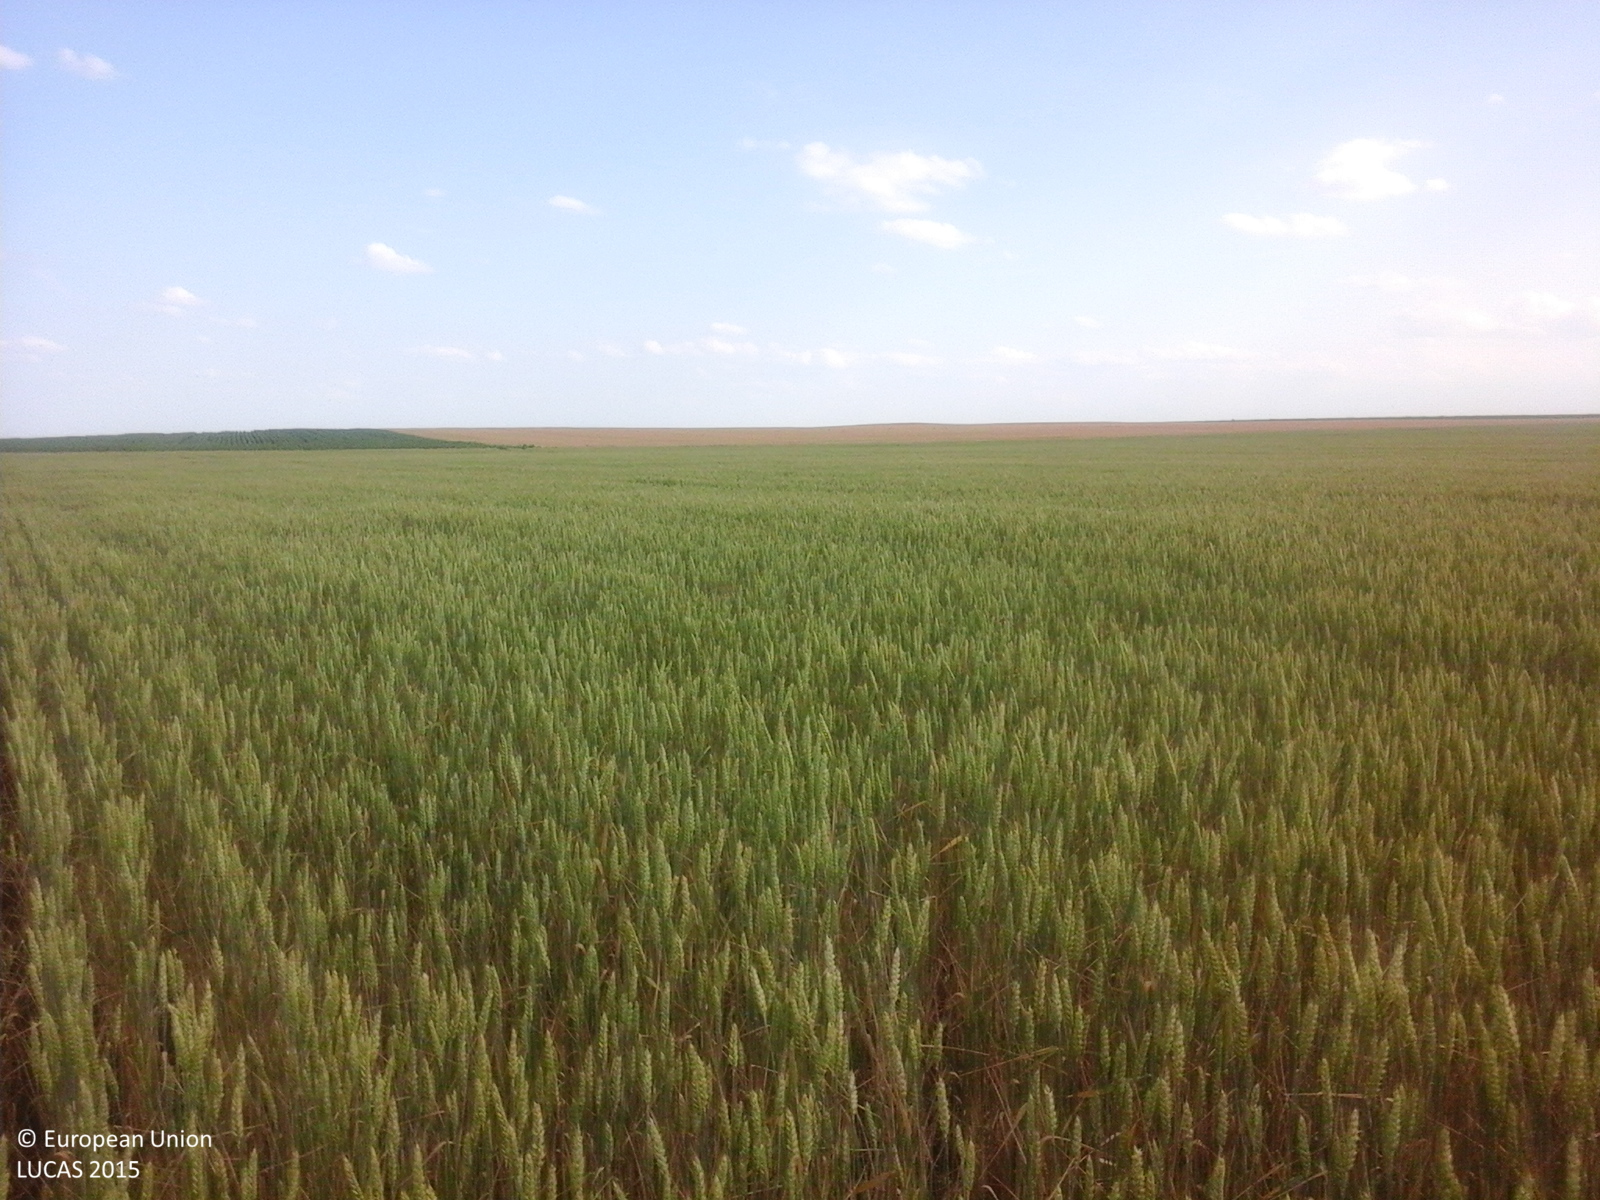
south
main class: Cropland
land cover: Common wheat
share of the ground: > 75 %
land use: Agriculture (excluding fallow land and kitchen gardens)
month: June
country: RO
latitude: 47.8869
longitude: 26.5006
